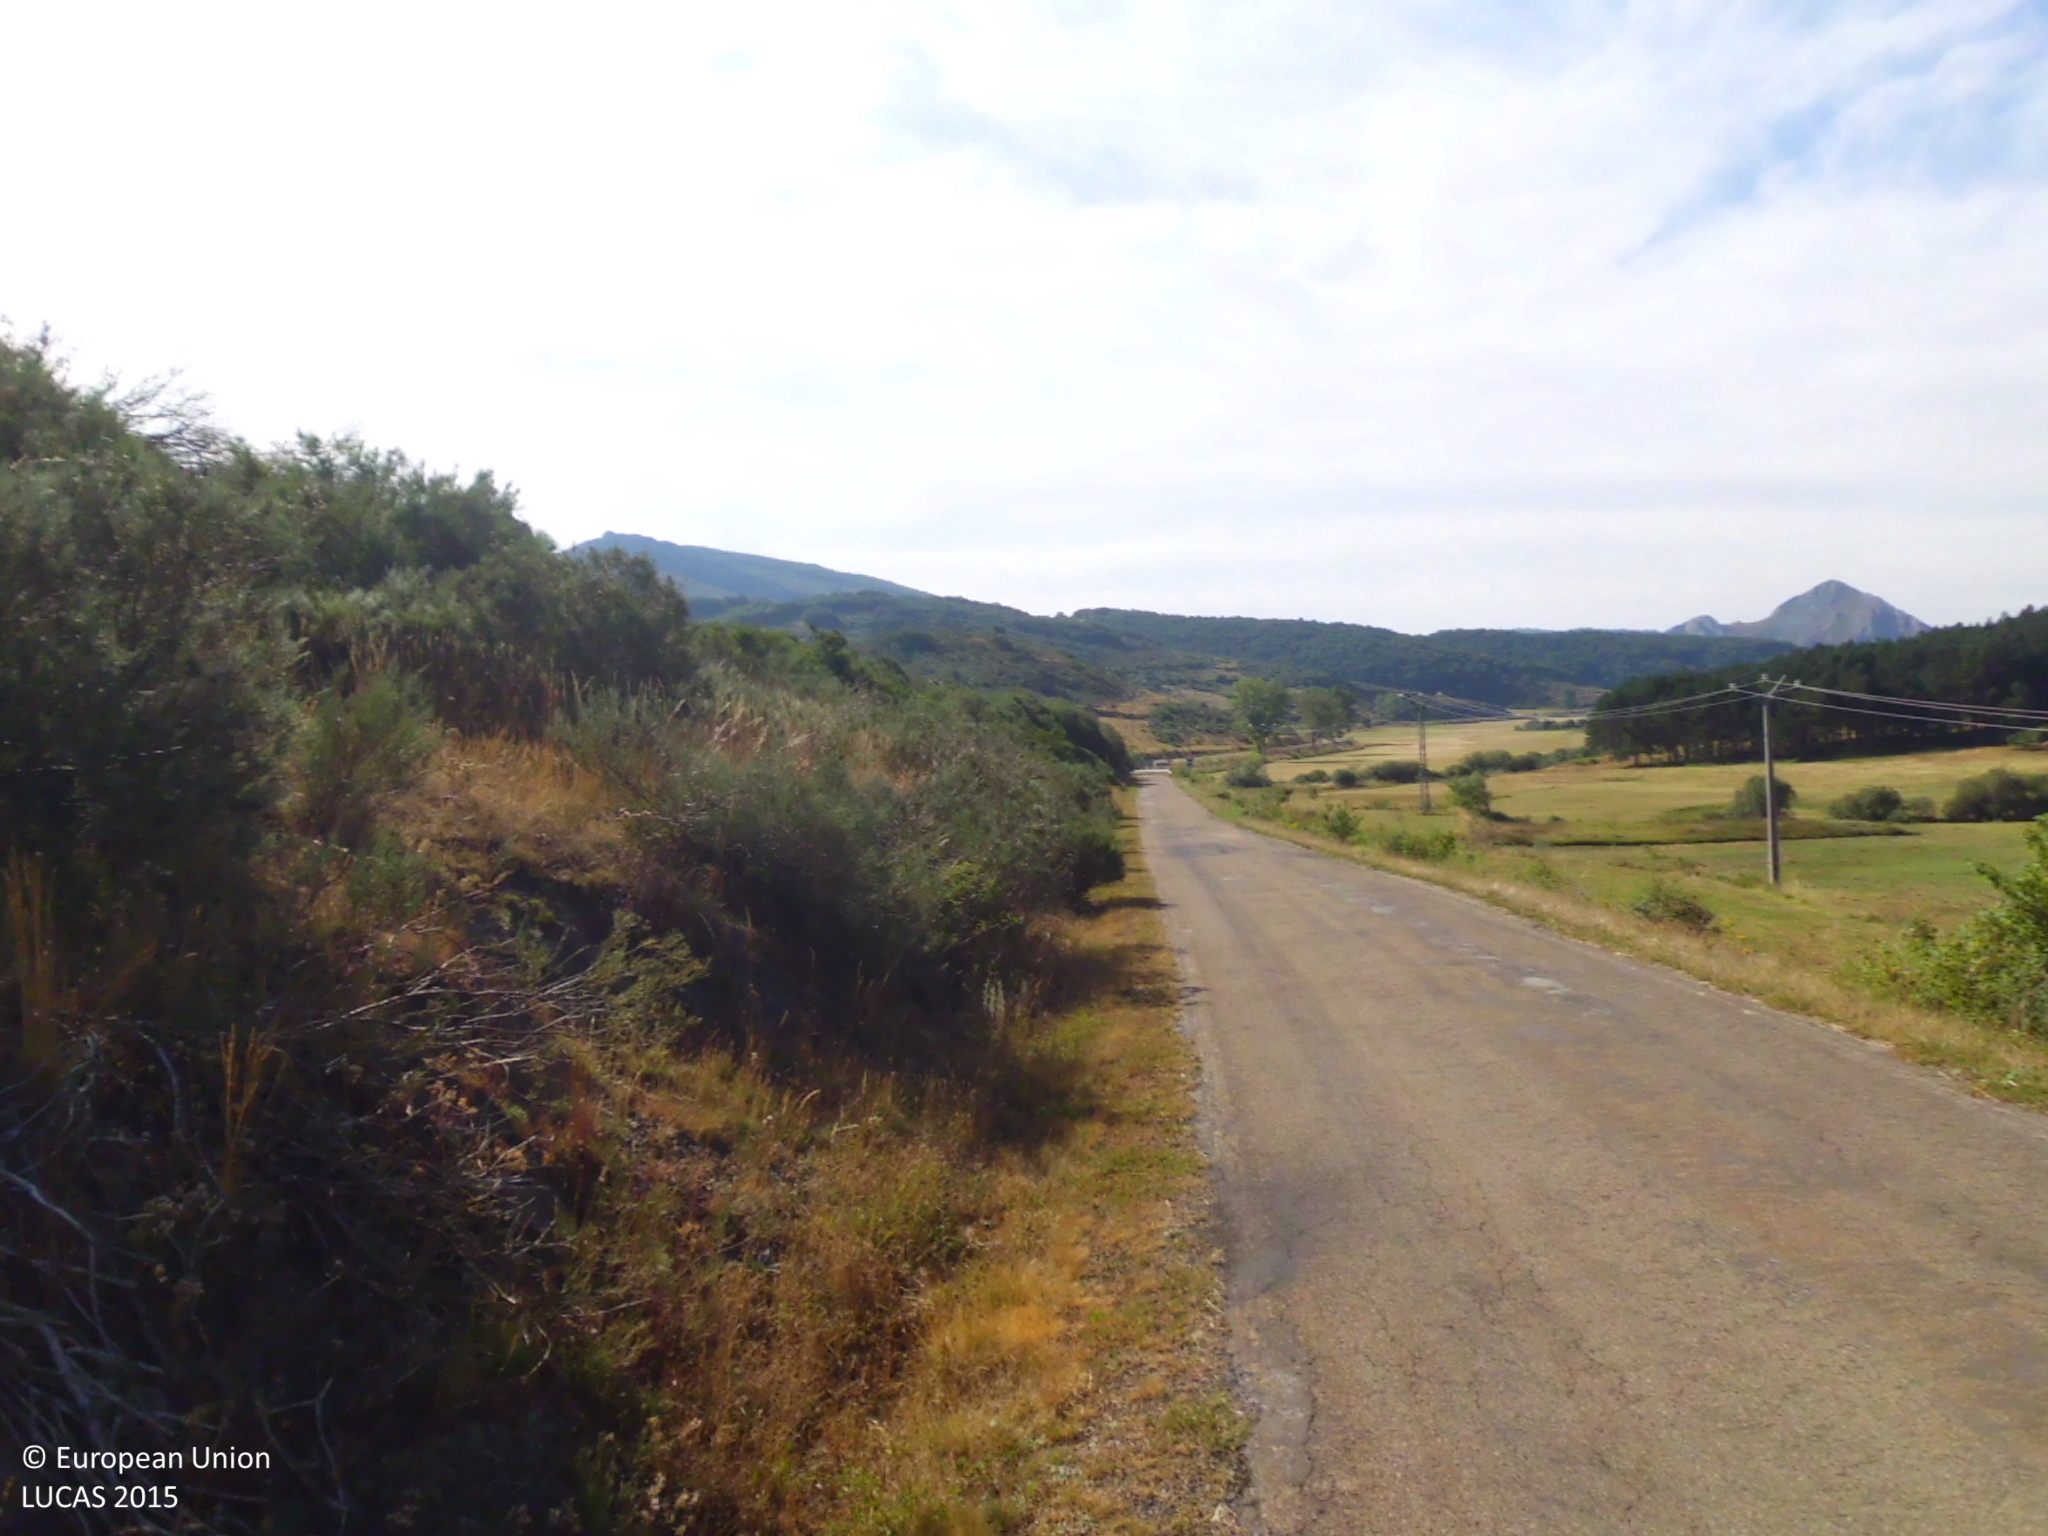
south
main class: Shrubland
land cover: Shrubland with sparse tree cover
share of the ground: > 75 %
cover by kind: shrubs 90 %, broadleaved forest trees 5 %, herbaceous plants 5 %
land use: Semi-natural and natural areas not in use
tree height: < 5 m
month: July
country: ES
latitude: 43.0148
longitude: -4.4980
